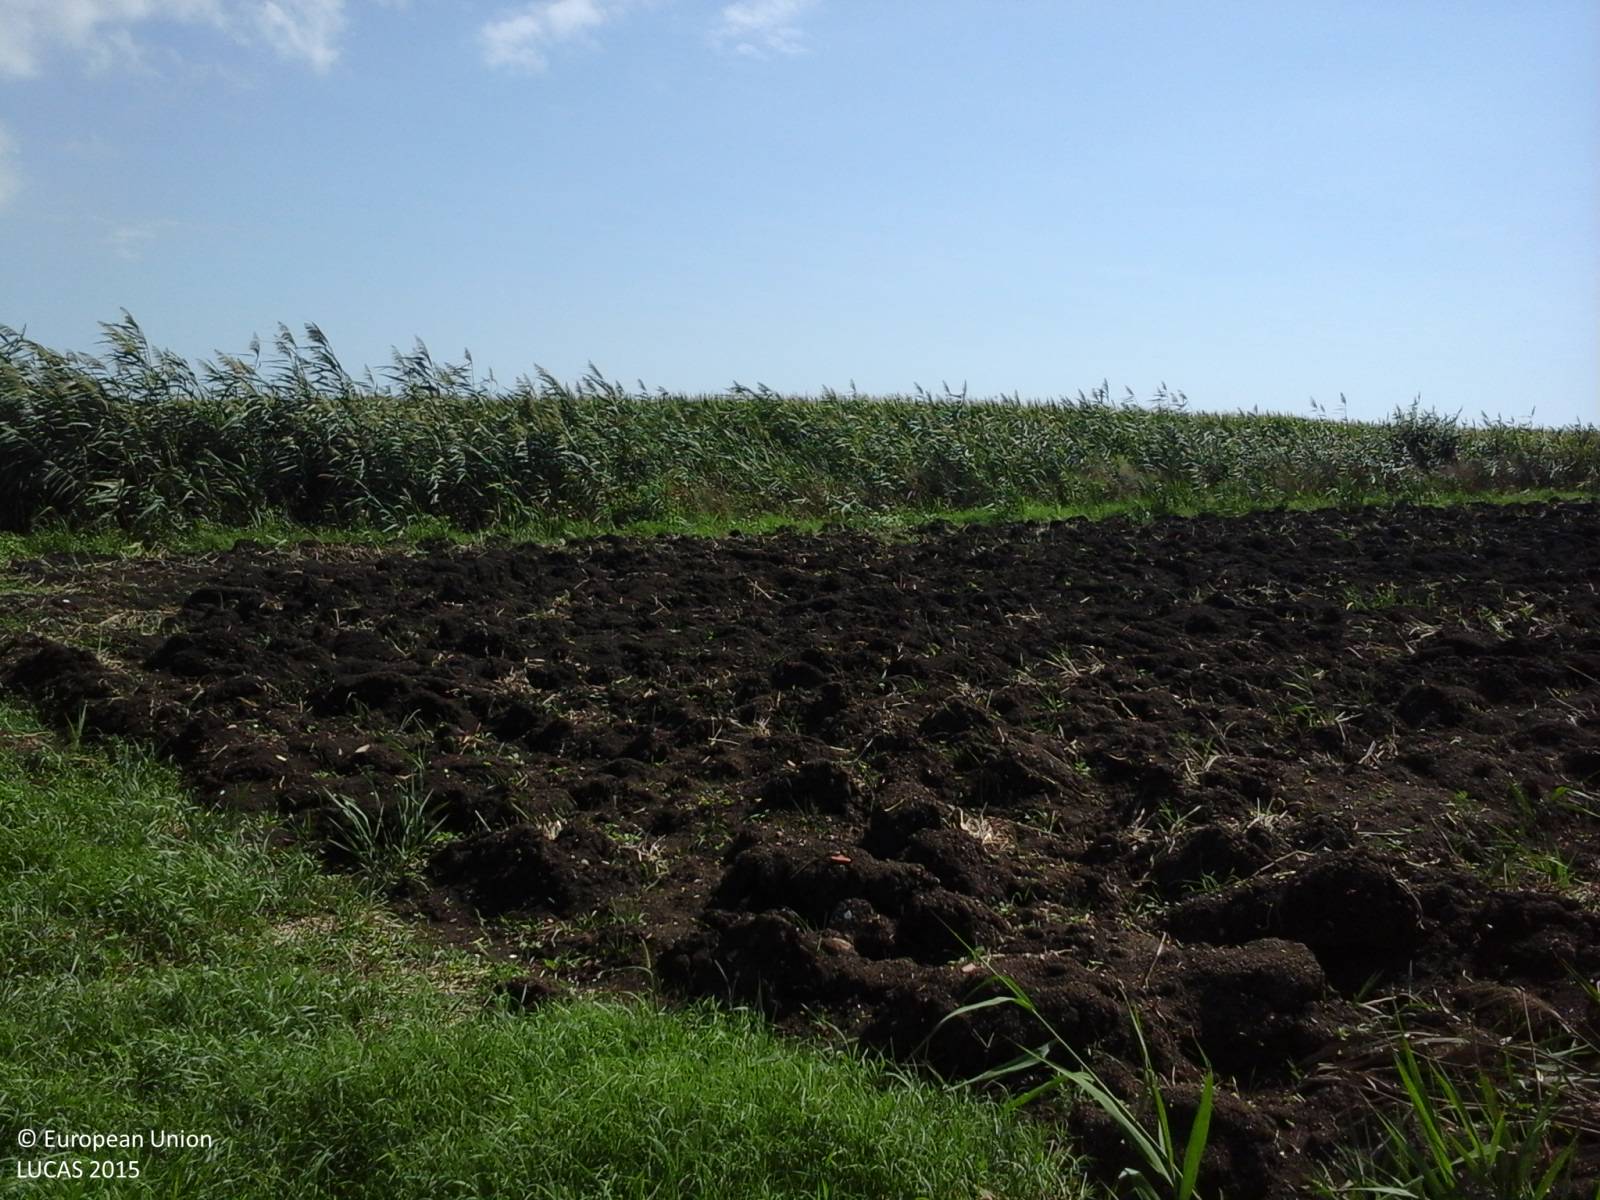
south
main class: Cropland
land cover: Maize
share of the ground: > 75 %
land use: Agriculture (excluding fallow land and kitchen gardens)
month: August
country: IT
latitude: 41.4685
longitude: 13.0651
